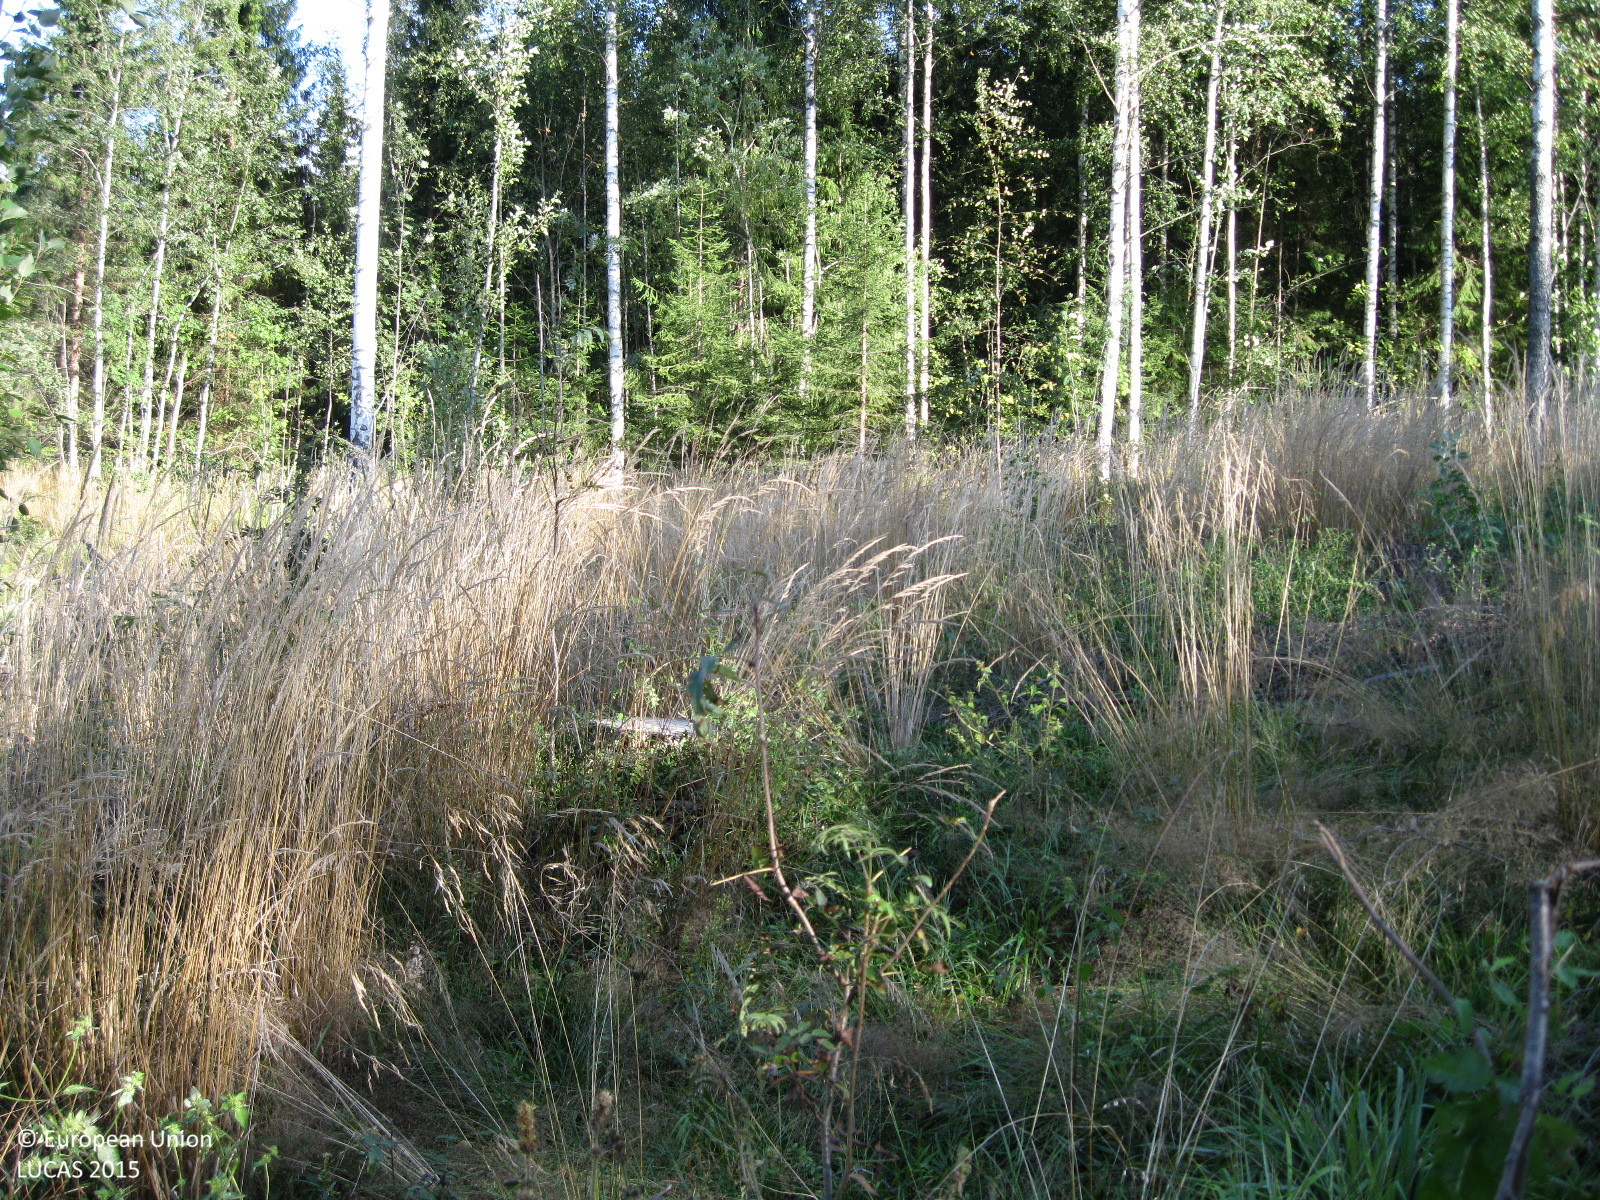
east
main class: Woodland
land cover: Broadleaved woodland
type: boreal forest
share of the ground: > 75 %
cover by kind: herbaceous plants 85 %, broadleaved forest trees 10 %, shrubs 5 %
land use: Forestry
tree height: > 5 m
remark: Nursery
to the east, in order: Broadleaved woodland; Spruce dominated mixed woodland; Tracks; Spruce dominated mixed woodland; Tracks; Spruce dominated coniferous woodland
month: September
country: FI
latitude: 60.5167
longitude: 24.7752
